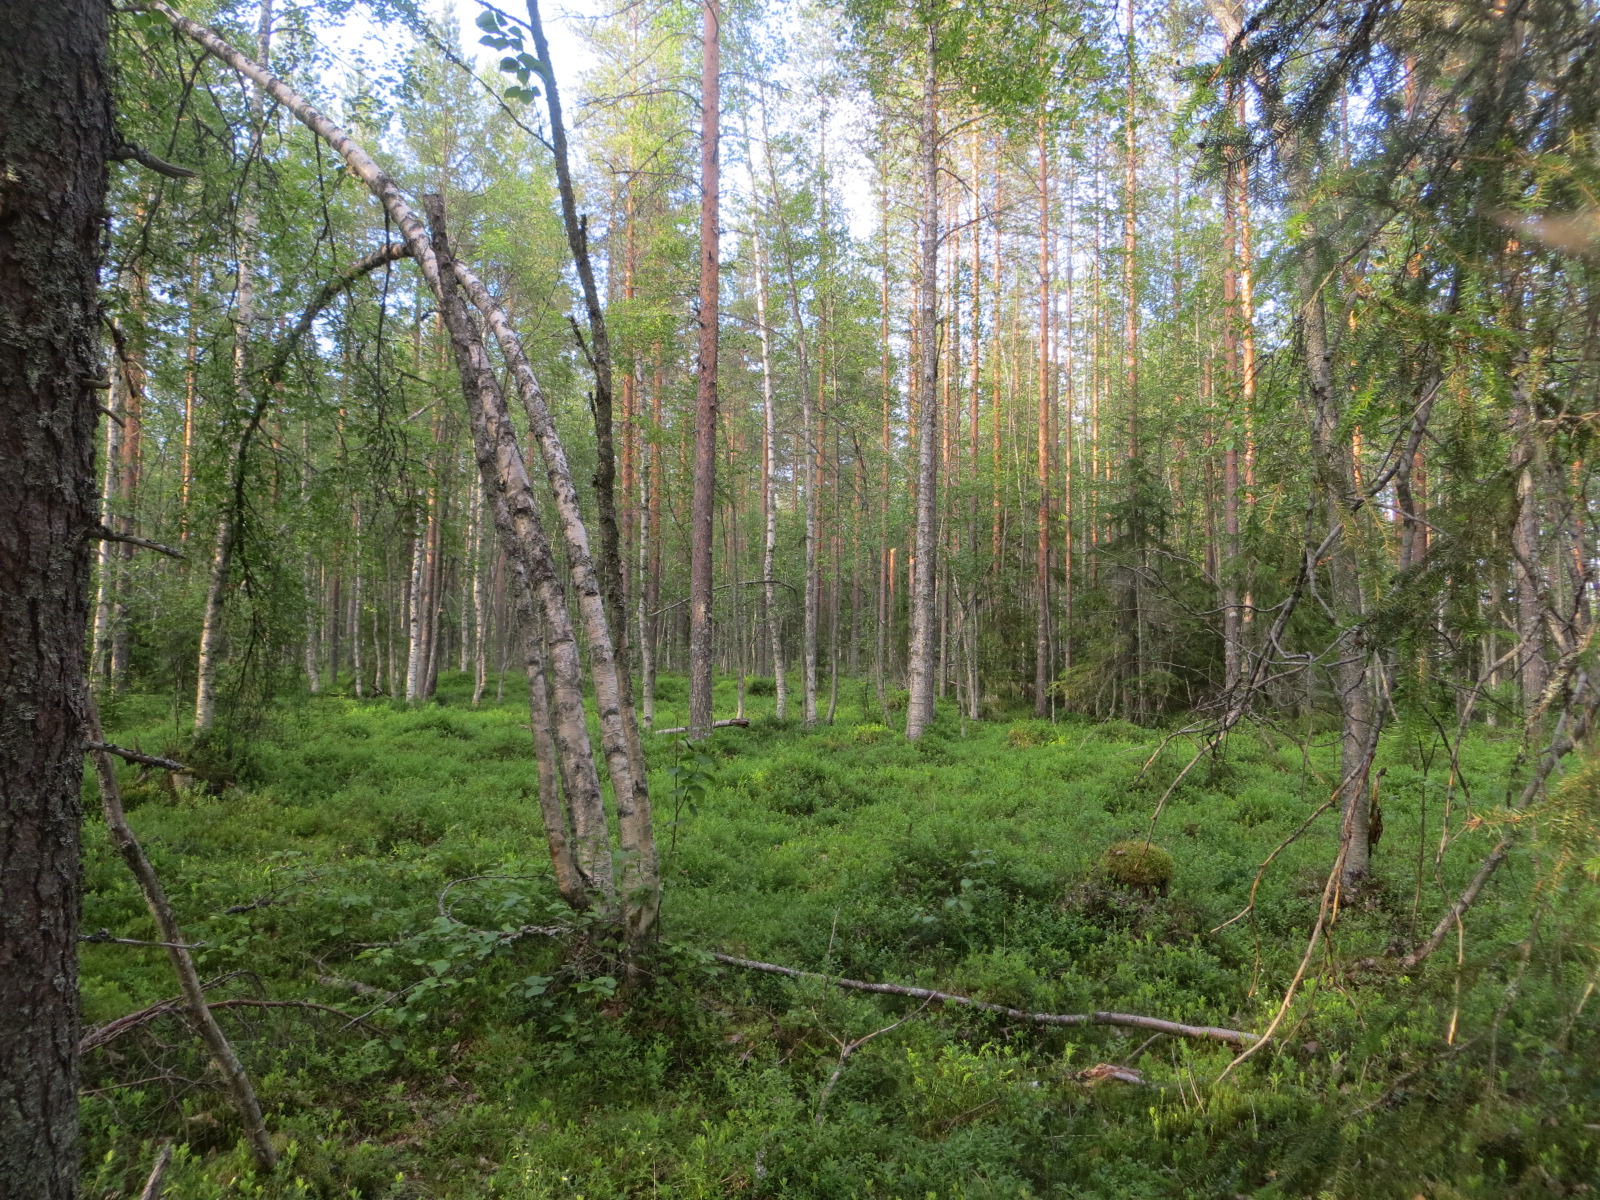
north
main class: Woodland
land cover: Pine dominated mixed woodland
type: boreal forest
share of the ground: 50 - 75 %
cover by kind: shrubs 40 %, coniferous forest trees 35 %, broadleaved forest trees 25 %
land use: Forestry
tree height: > 5 m
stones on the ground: 25 - 50 %
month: July
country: FI
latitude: 65.6301
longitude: 26.0521
